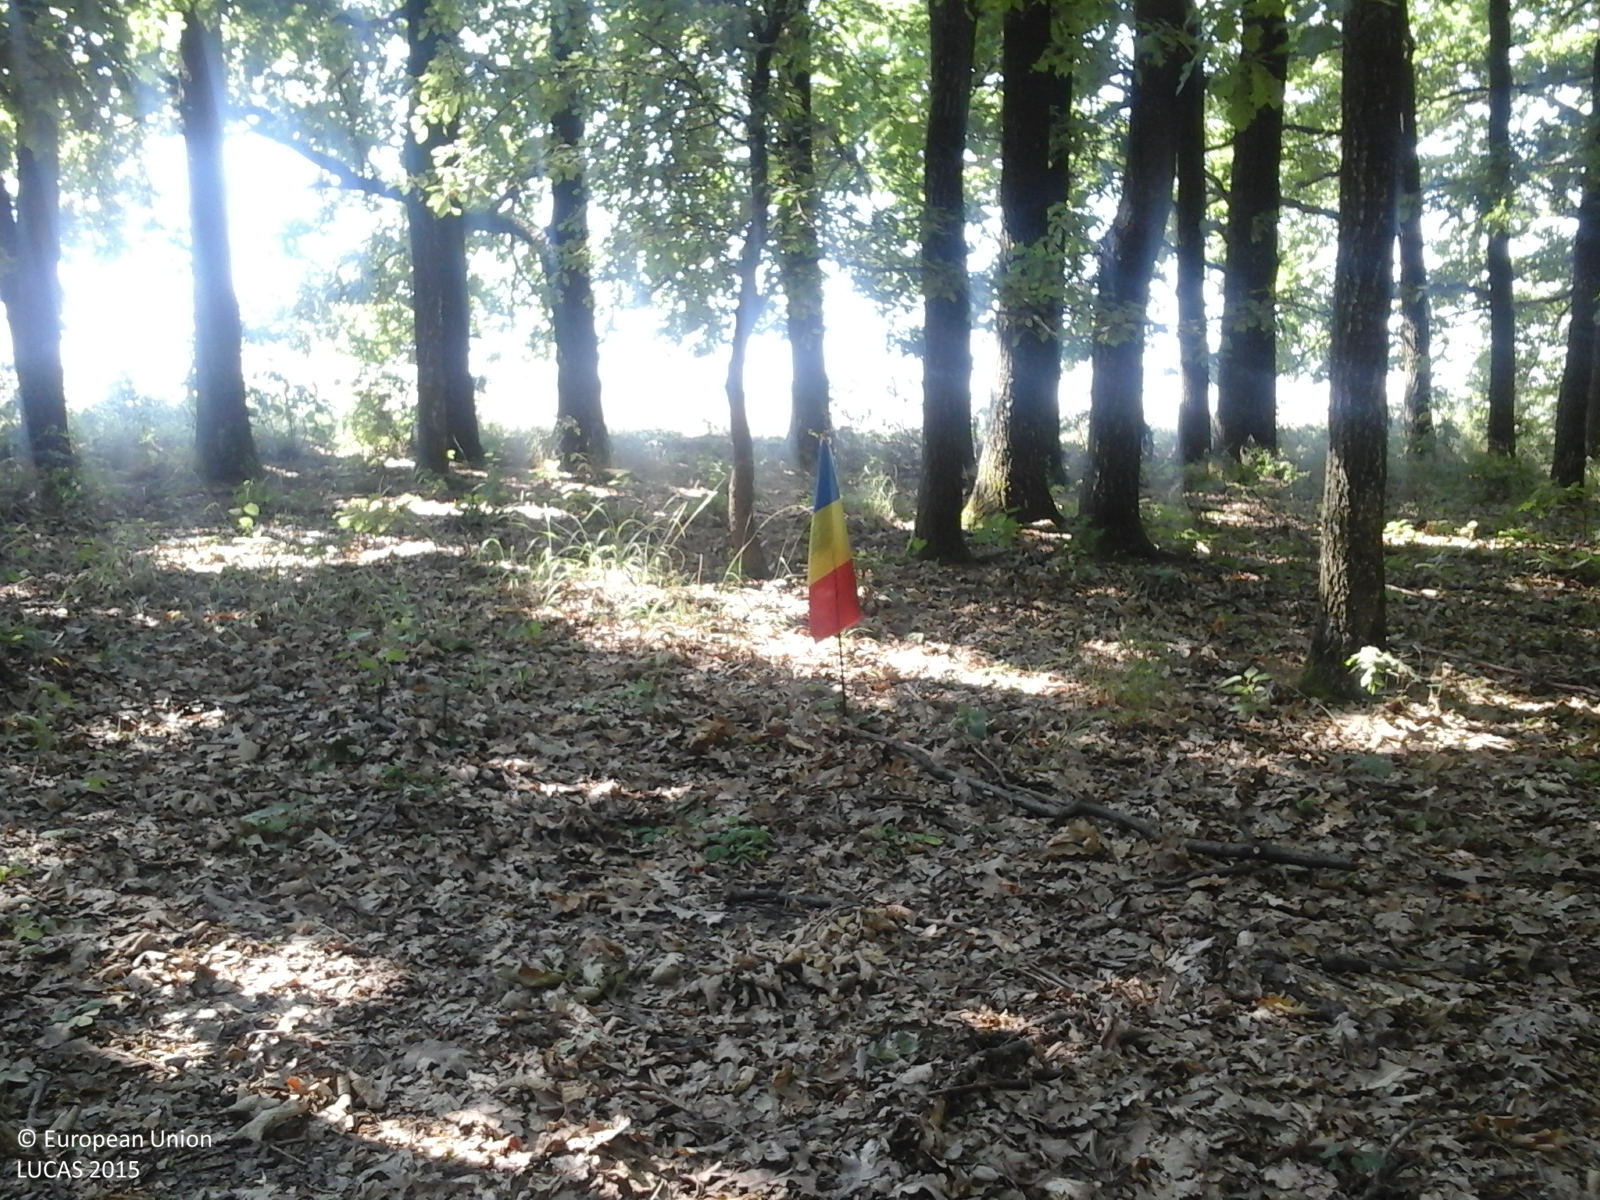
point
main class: Woodland
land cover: Broadleaved woodland
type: acidophilous oak and oak-birch forest
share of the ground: > 75 %
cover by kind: broadleaved forest trees 100 %
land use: Forestry
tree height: > 5 m
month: July
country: RO
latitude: 44.8186
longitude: 24.5546
